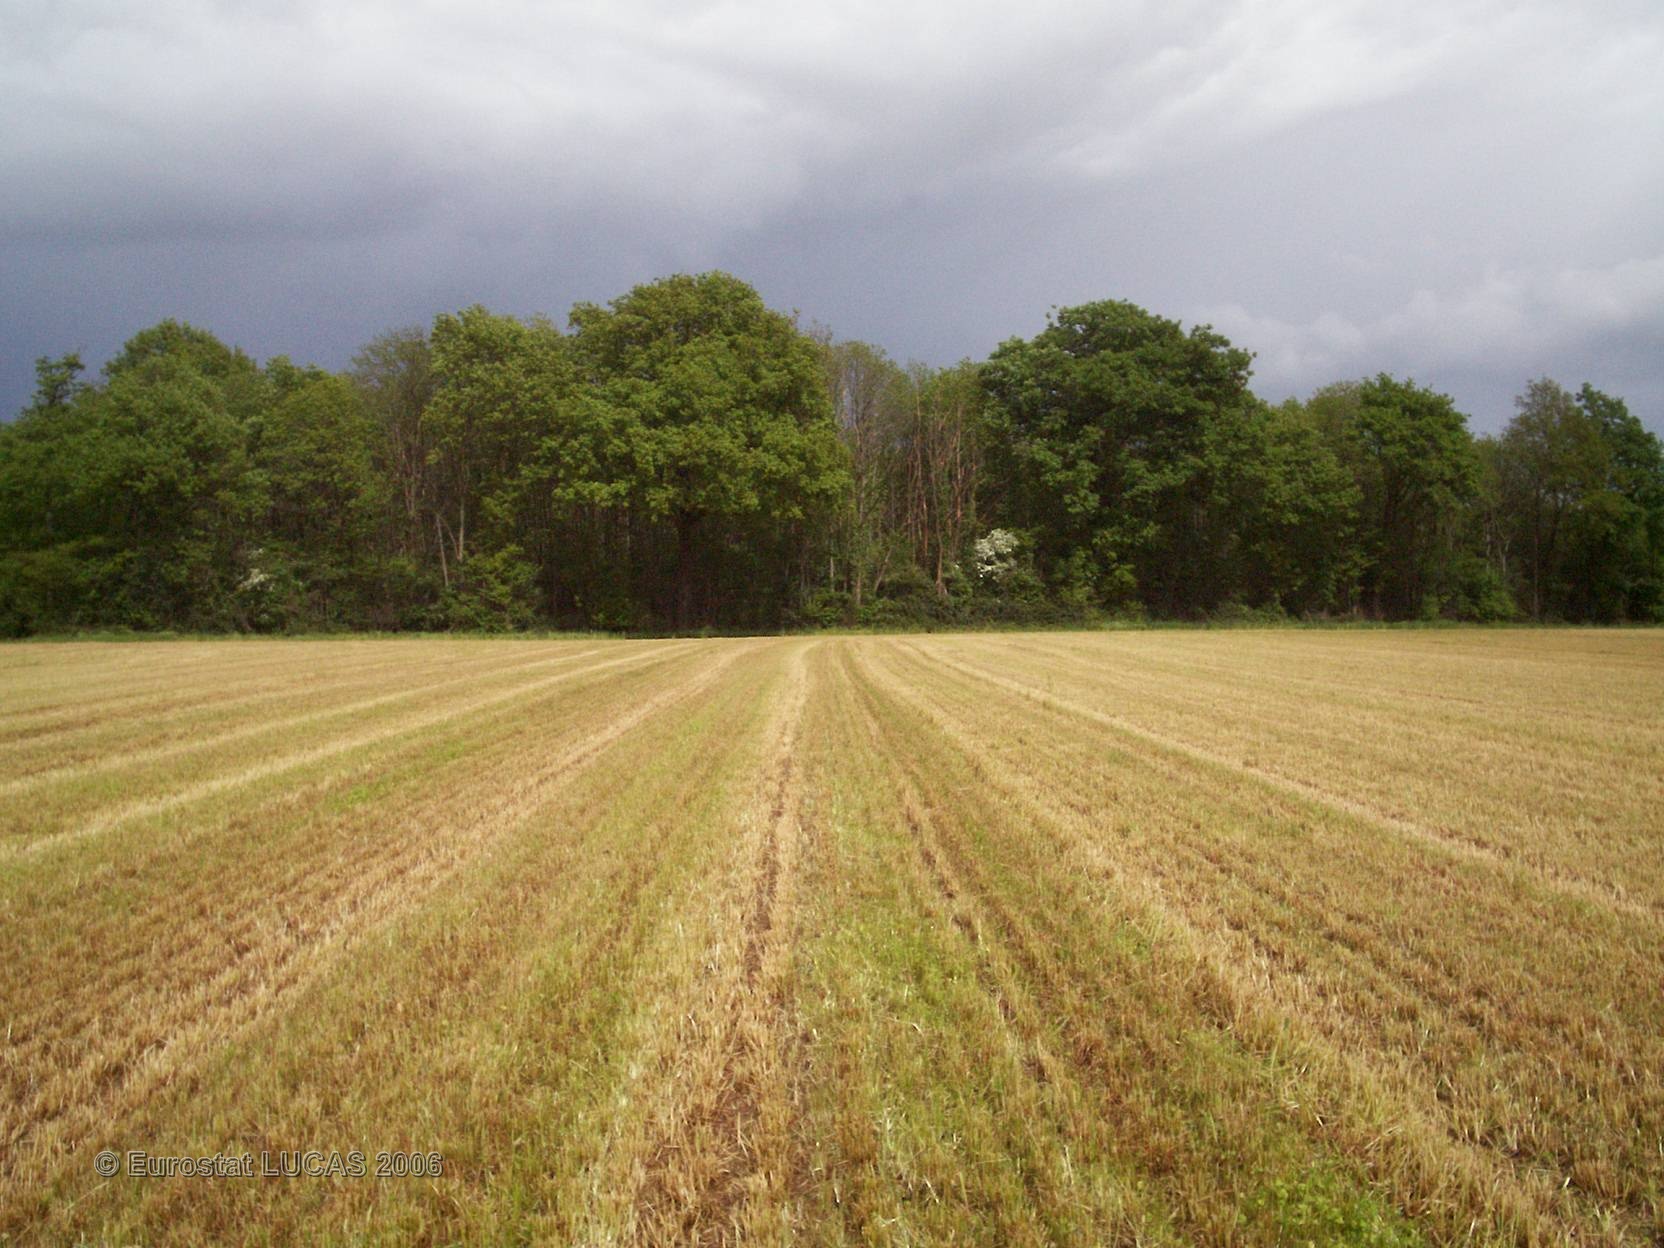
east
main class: Grassland
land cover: Grassland without tree/shrub cover
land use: Agriculture (excluding fallow land and kitchen gardens)
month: May
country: FR
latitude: 46.6173
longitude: -0.2756
